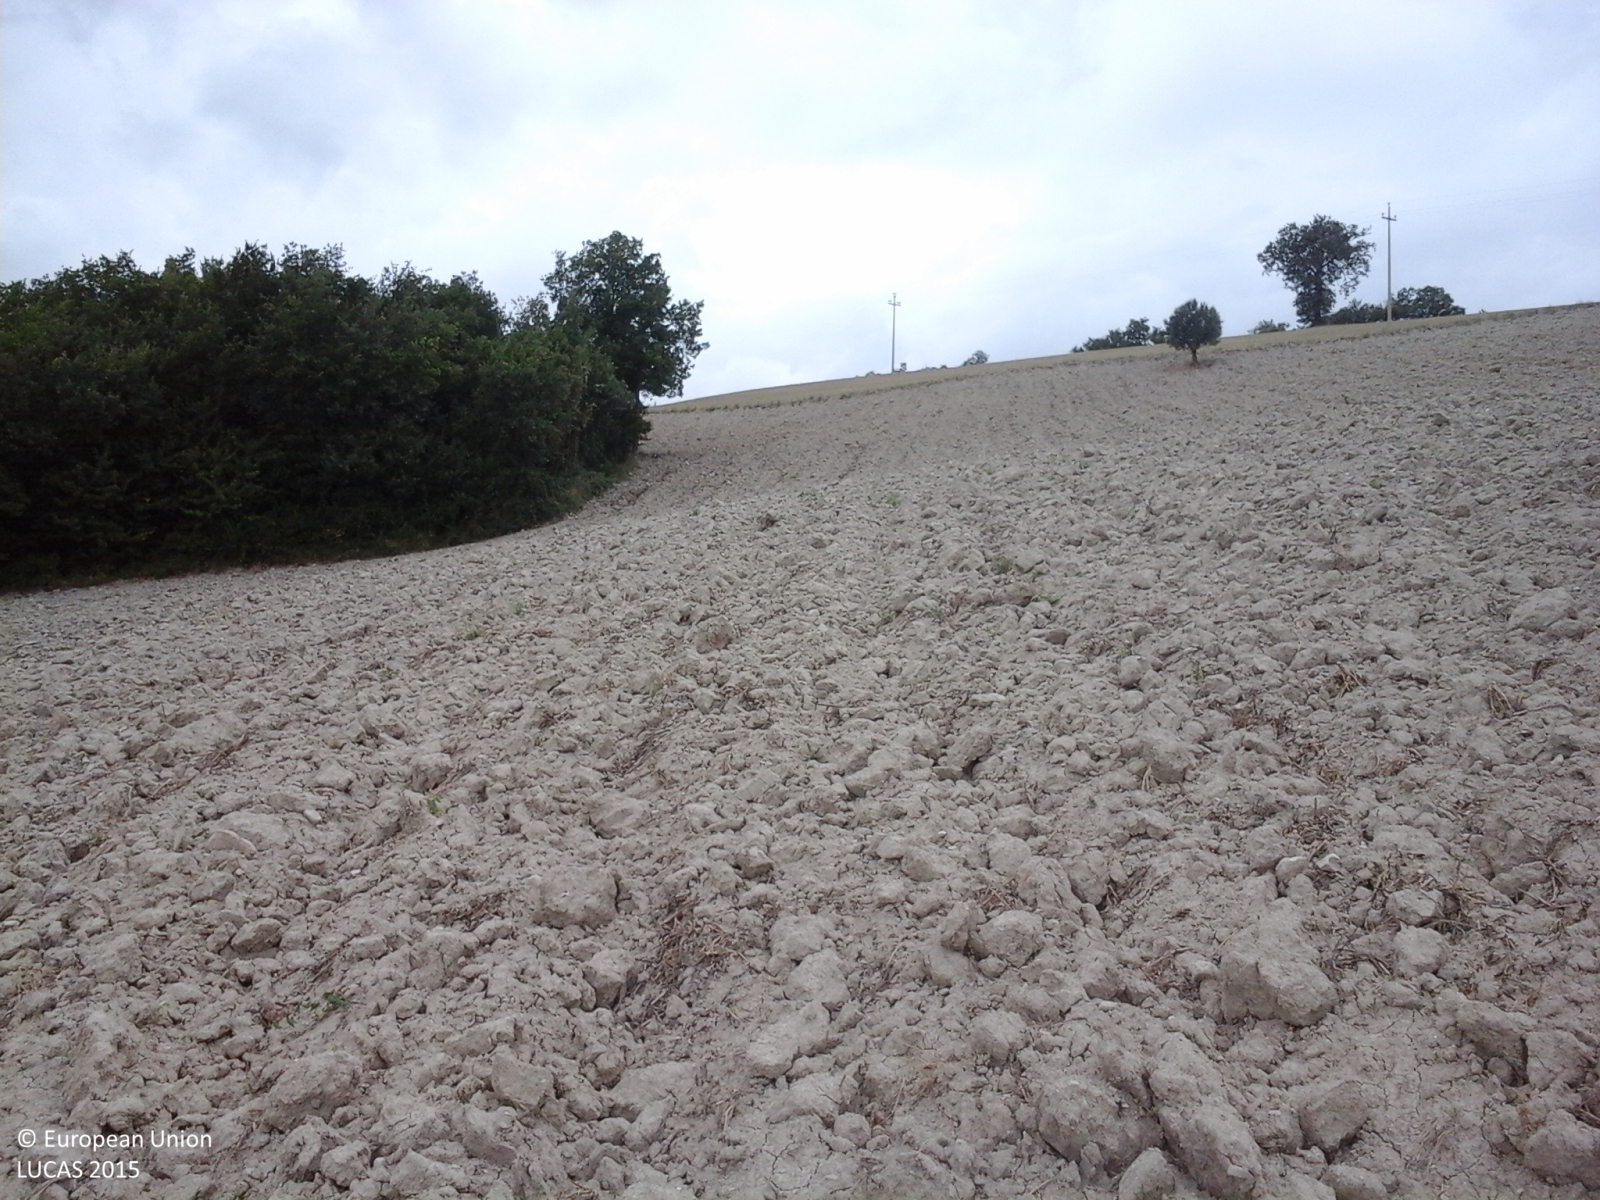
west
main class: Cropland
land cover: Dry pulses
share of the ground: > 75 %
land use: Agriculture (excluding fallow land and kitchen gardens)
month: July
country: IT
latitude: 43.2553
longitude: 13.1573
